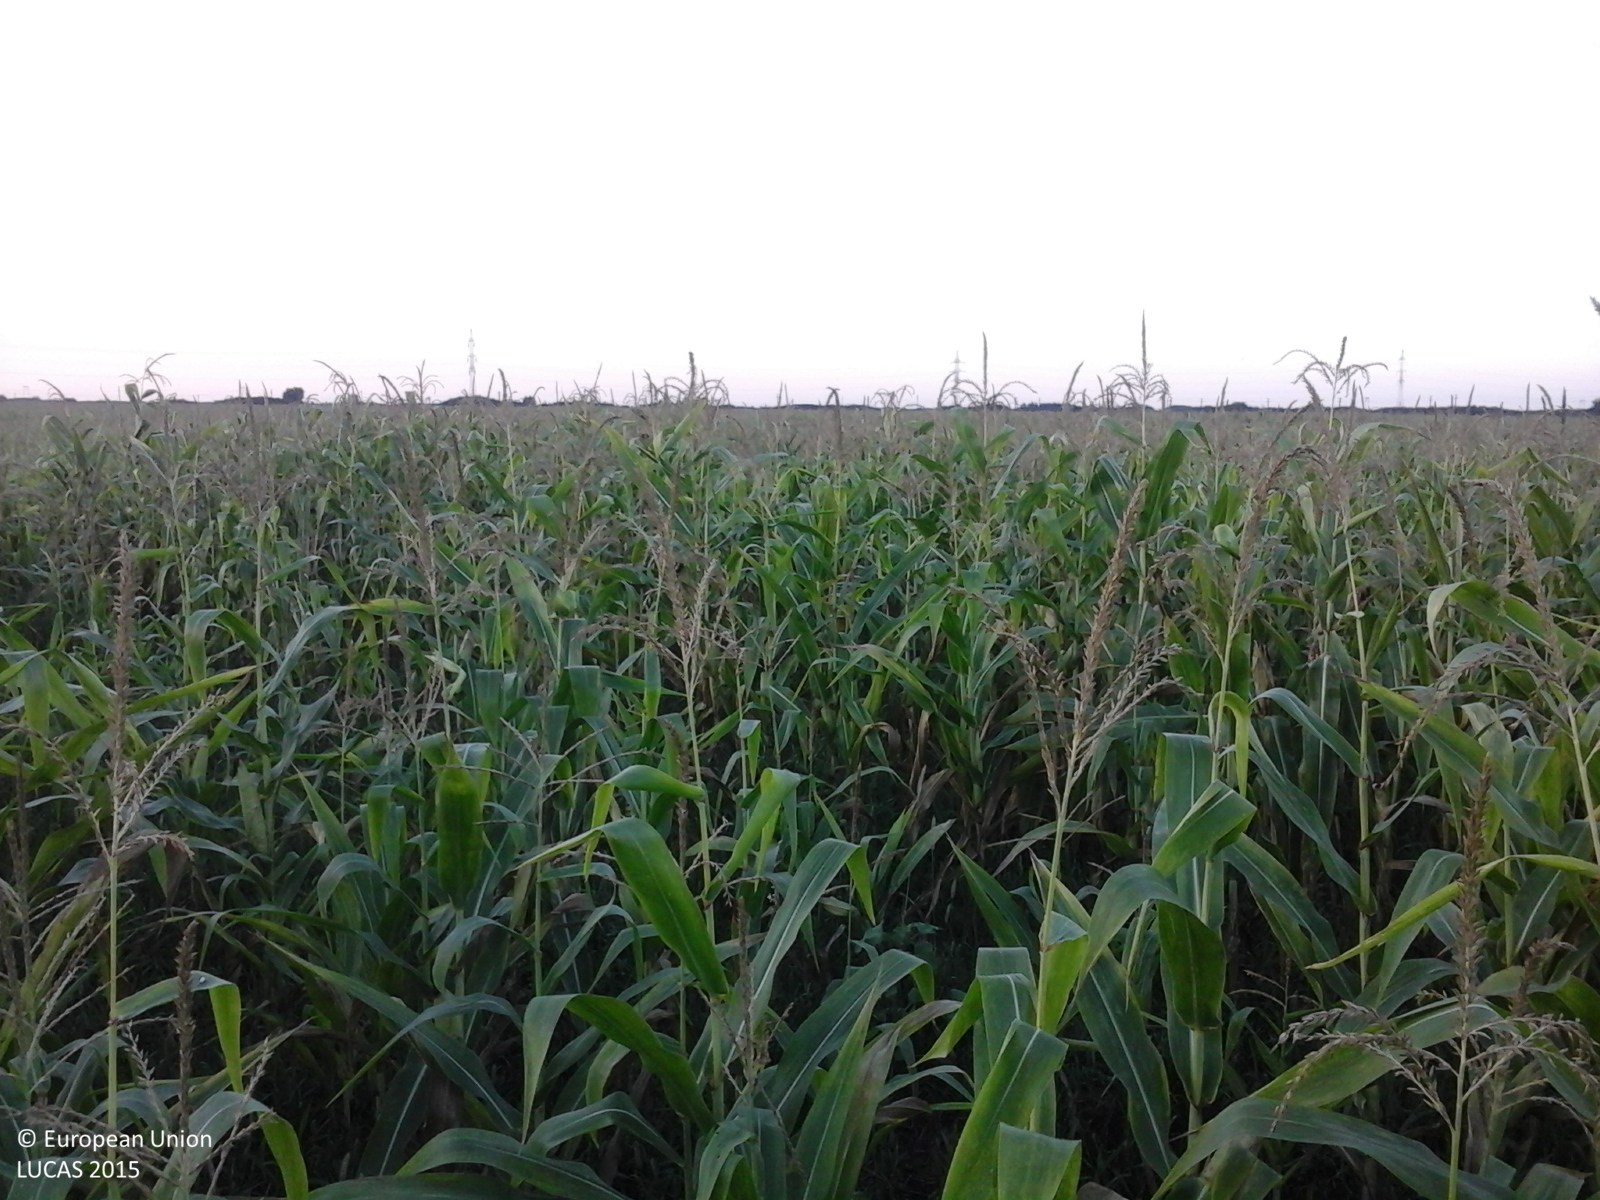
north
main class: Cropland
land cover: Maize
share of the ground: > 75 %
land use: Agriculture (excluding fallow land and kitchen gardens)
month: August
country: RO
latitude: 46.2134
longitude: 21.2194
